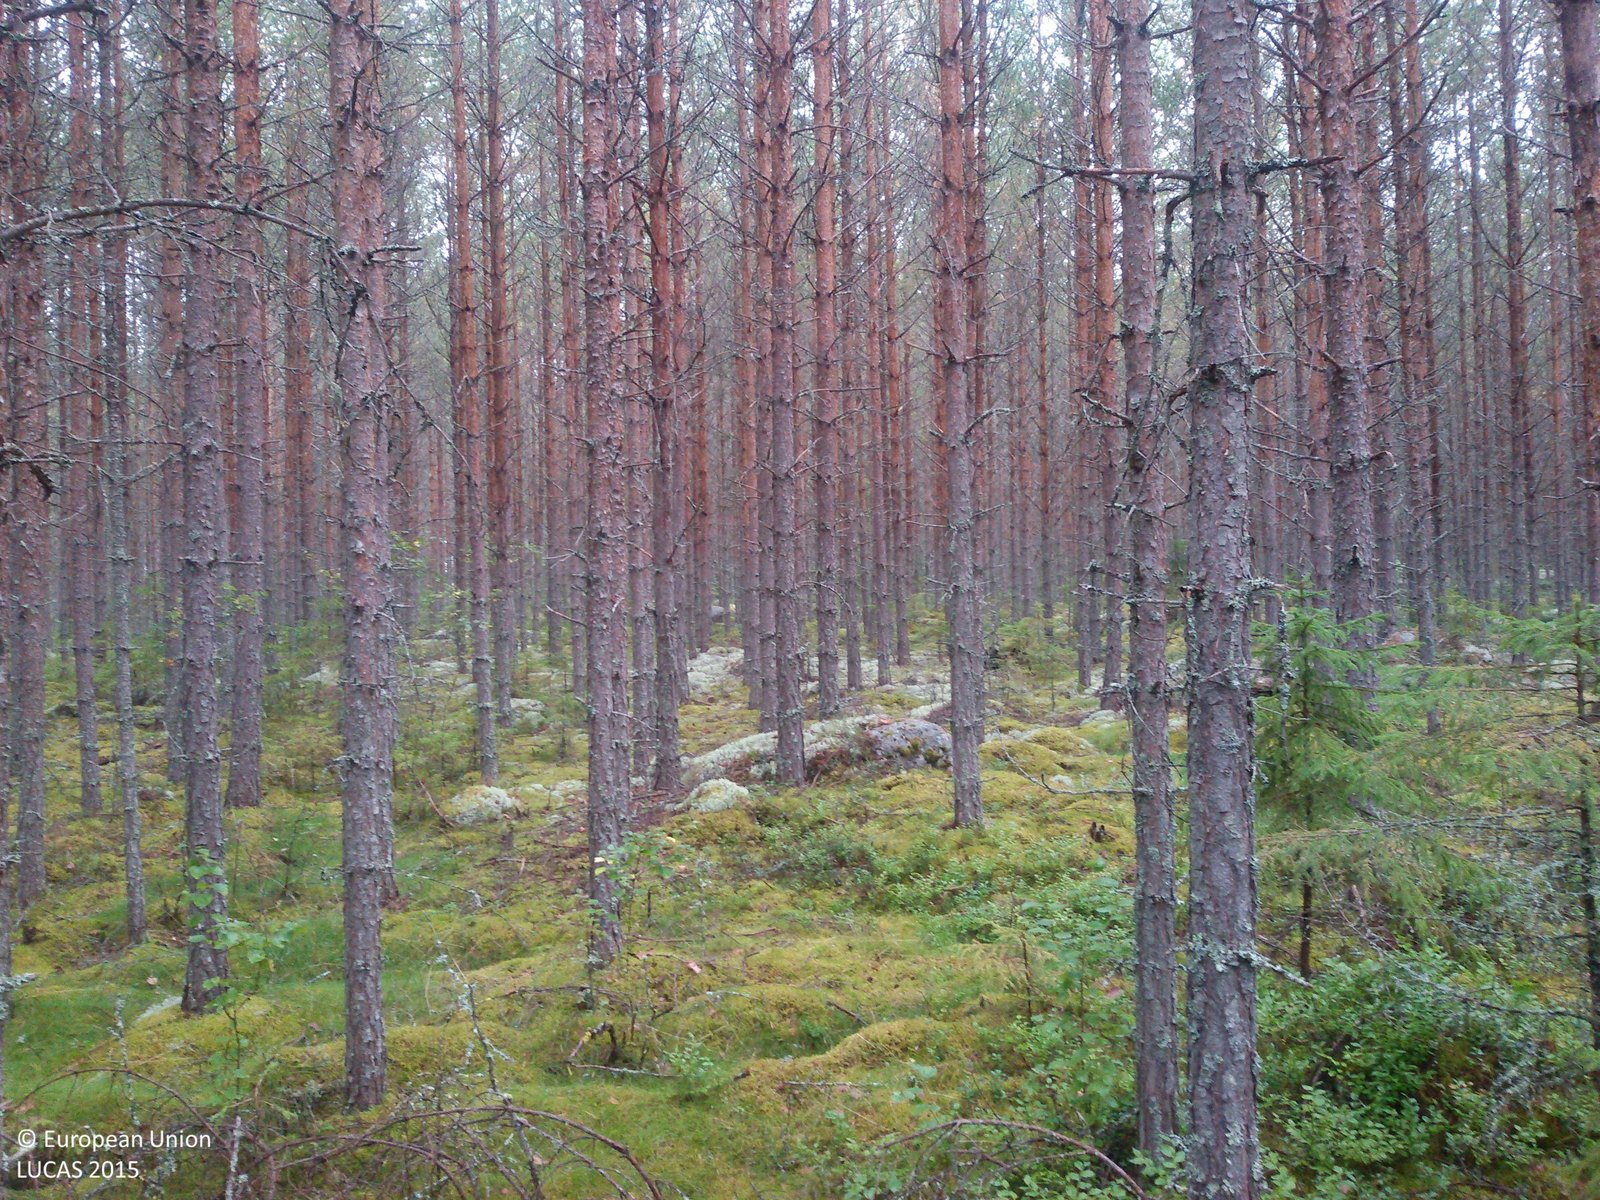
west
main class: Woodland
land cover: Pine dominated coniferous woodland
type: boreal forest
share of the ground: > 75 %
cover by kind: coniferous forest trees 85 %, shrubs 5 %, herbaceous plants 5 %, lichens and mosses 5 %
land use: Forestry
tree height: > 5 m
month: September
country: SE
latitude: 60.8222
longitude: 15.7421
